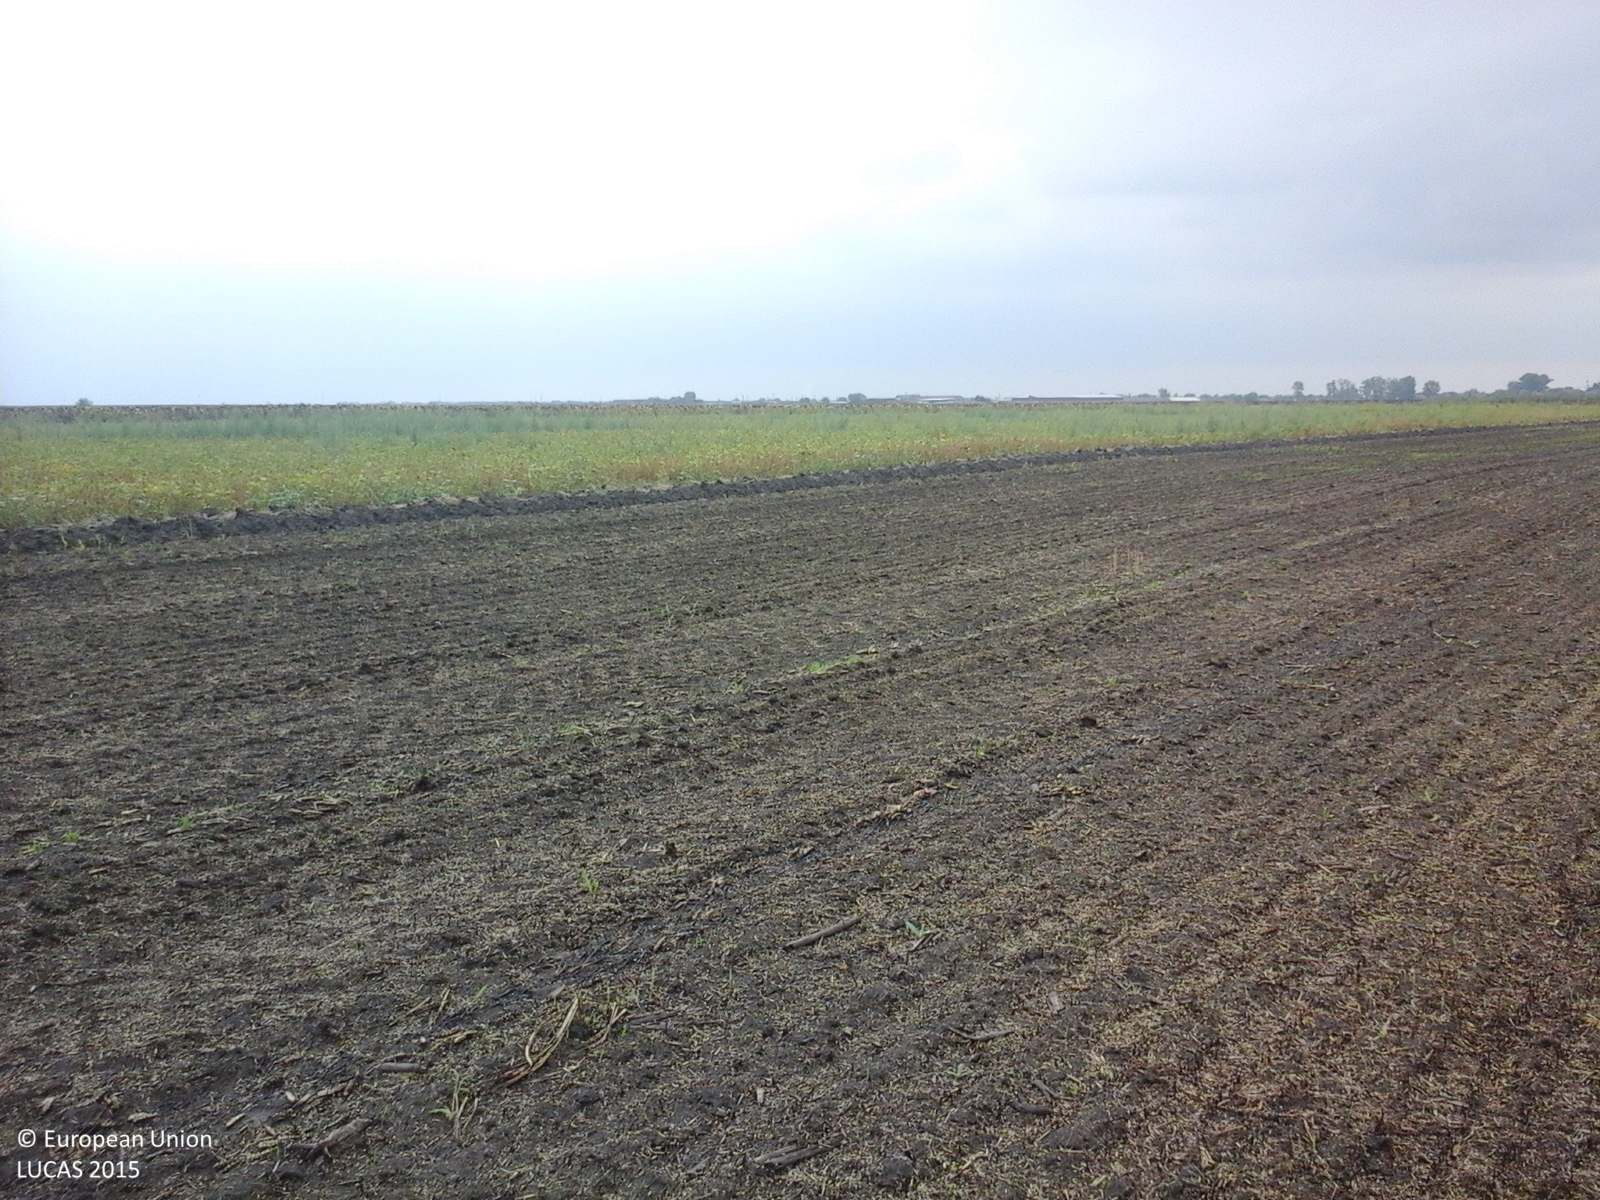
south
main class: Cropland
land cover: Common wheat
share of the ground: < 10 %
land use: Agriculture (excluding fallow land and kitchen gardens)
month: August
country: RO
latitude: 46.1417
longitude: 20.3147
